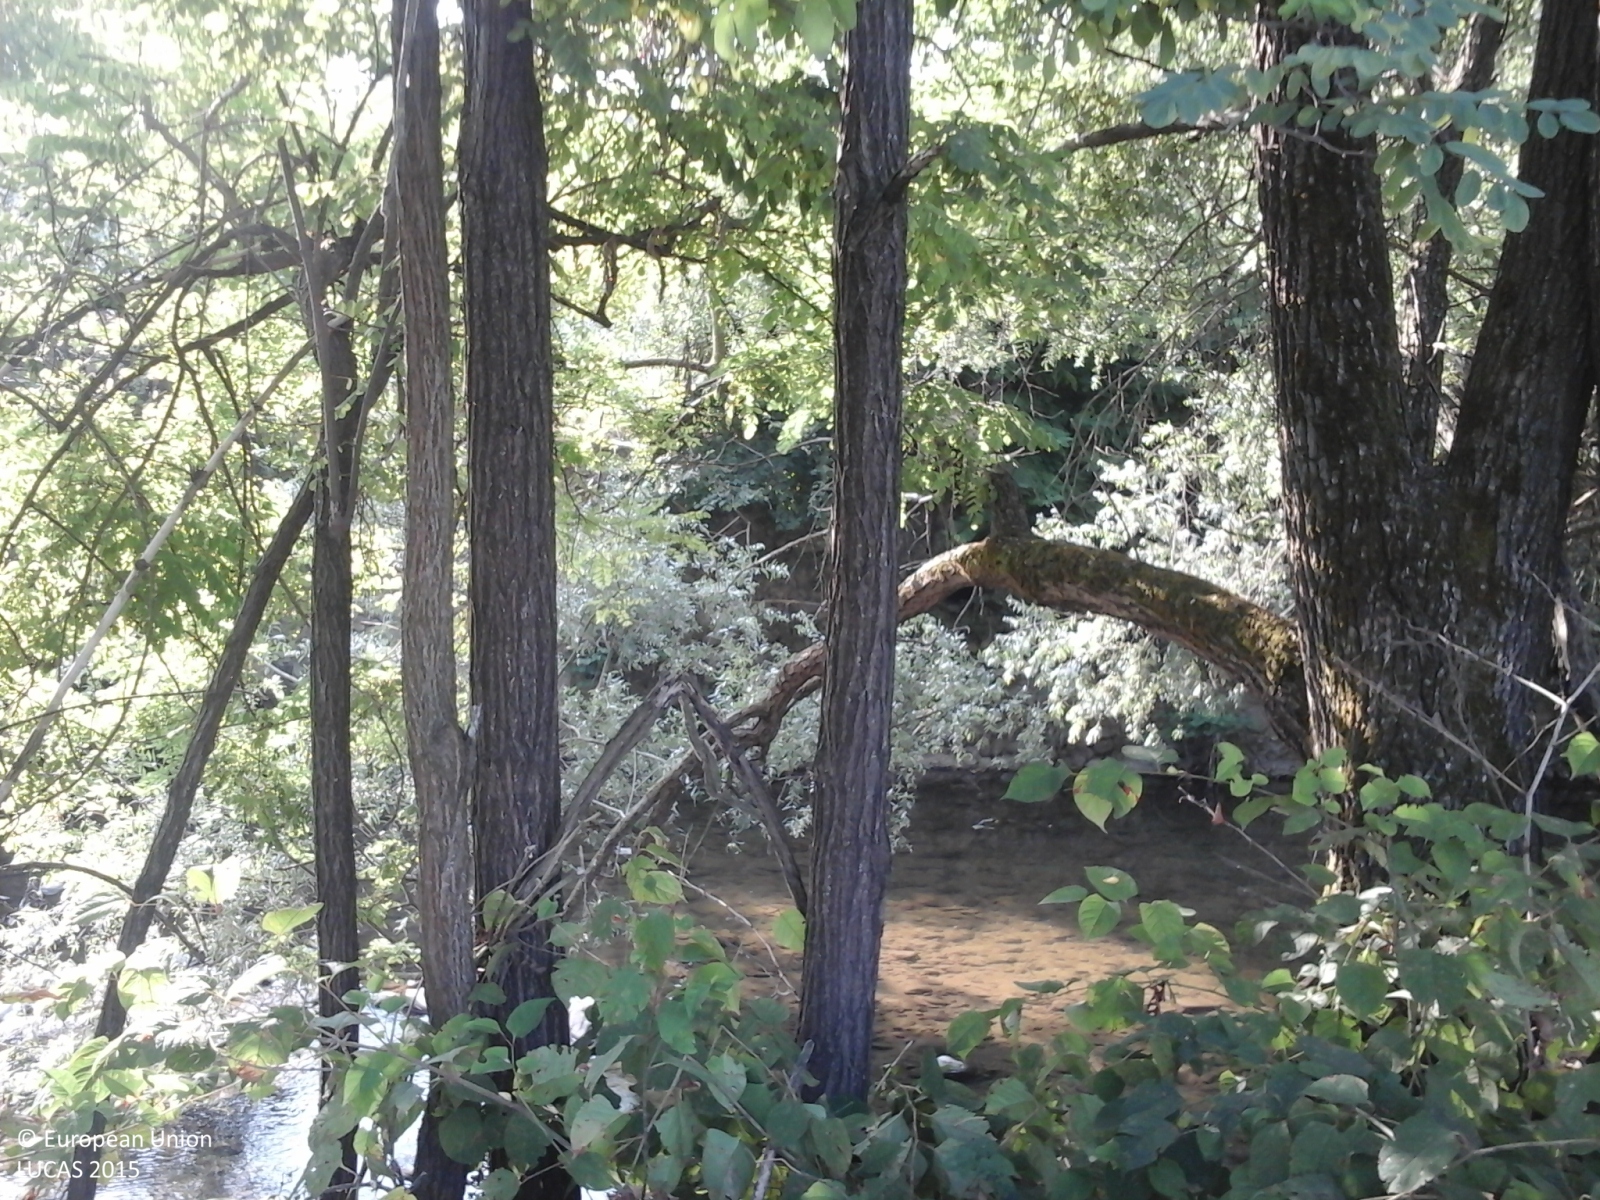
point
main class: Woodland
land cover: Broadleaved woodland
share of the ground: > 75 %
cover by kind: broadleaved forest trees 95 %, shrubs 5 %
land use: Semi-natural and natural areas not in use
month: August
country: IT
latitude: 44.4001
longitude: 7.8325
